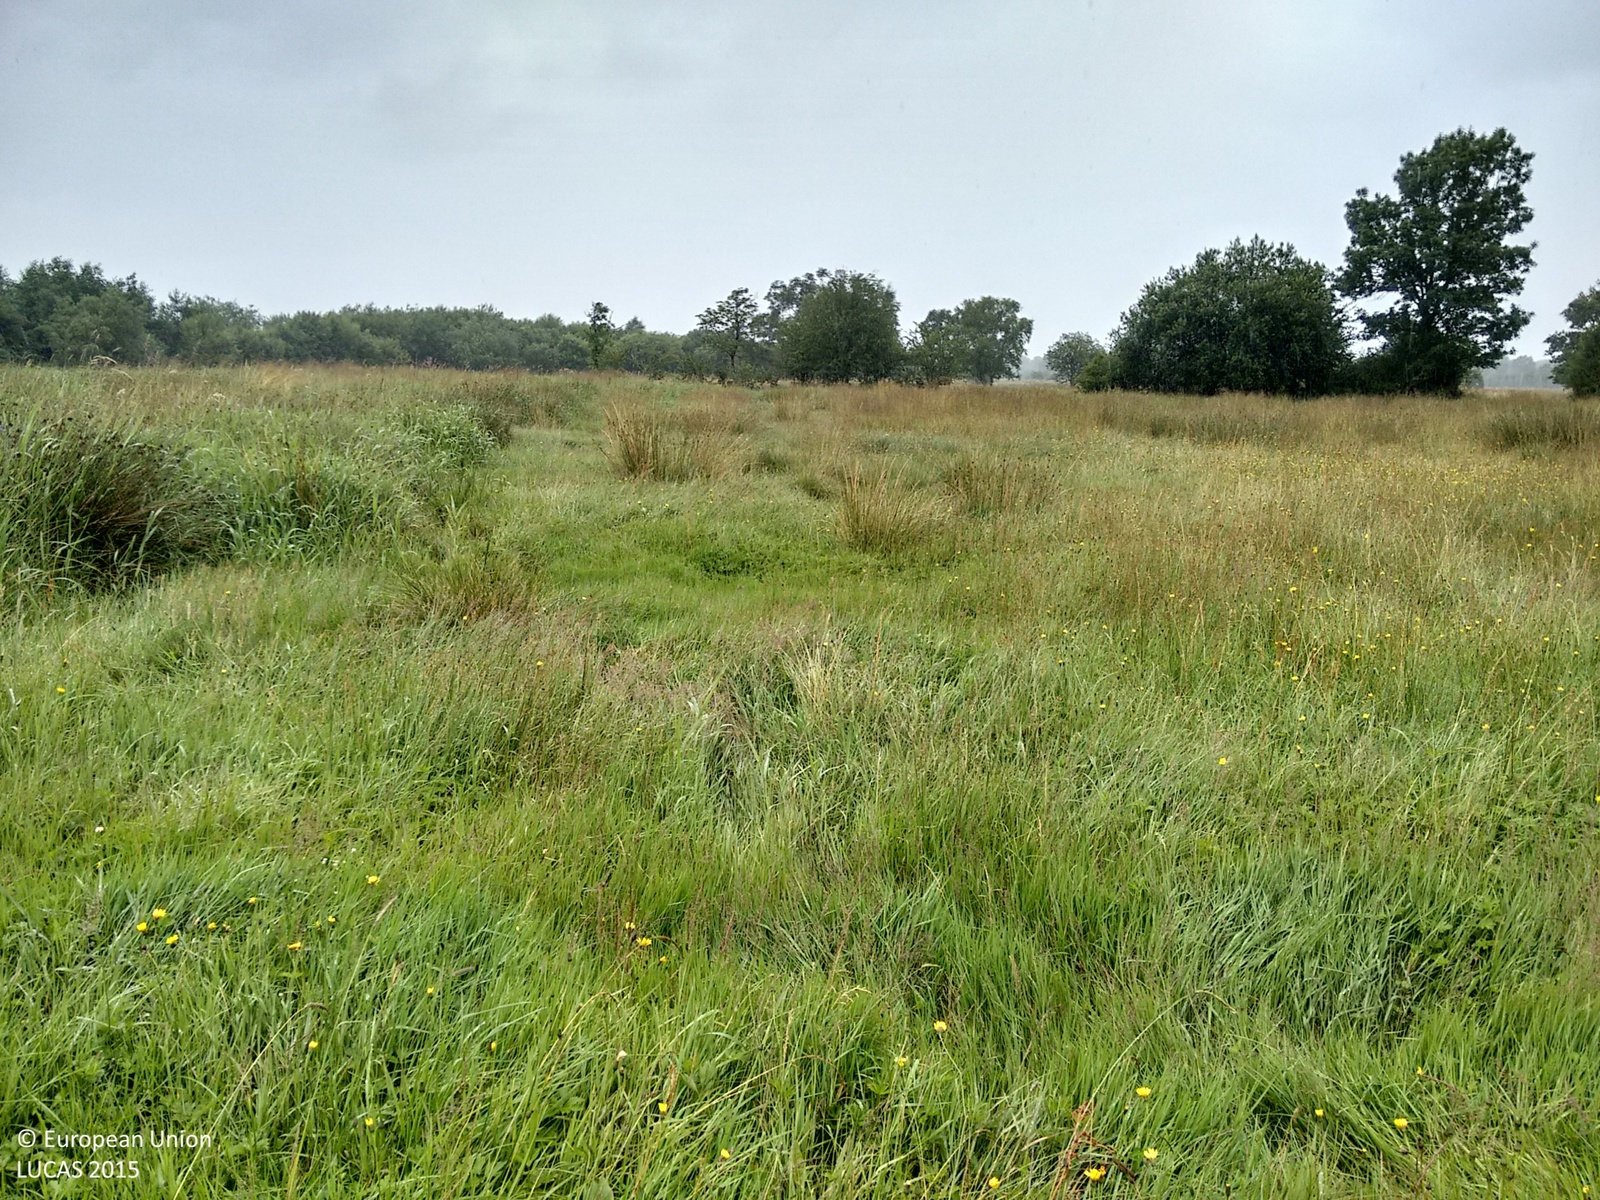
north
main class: Grassland
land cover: Grassland without tree/shrub cover
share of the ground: > 75 %
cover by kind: herbaceous plants 100 %
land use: Agriculture (excluding fallow land and kitchen gardens)
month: July
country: IE
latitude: 53.8103
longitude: -7.8622
